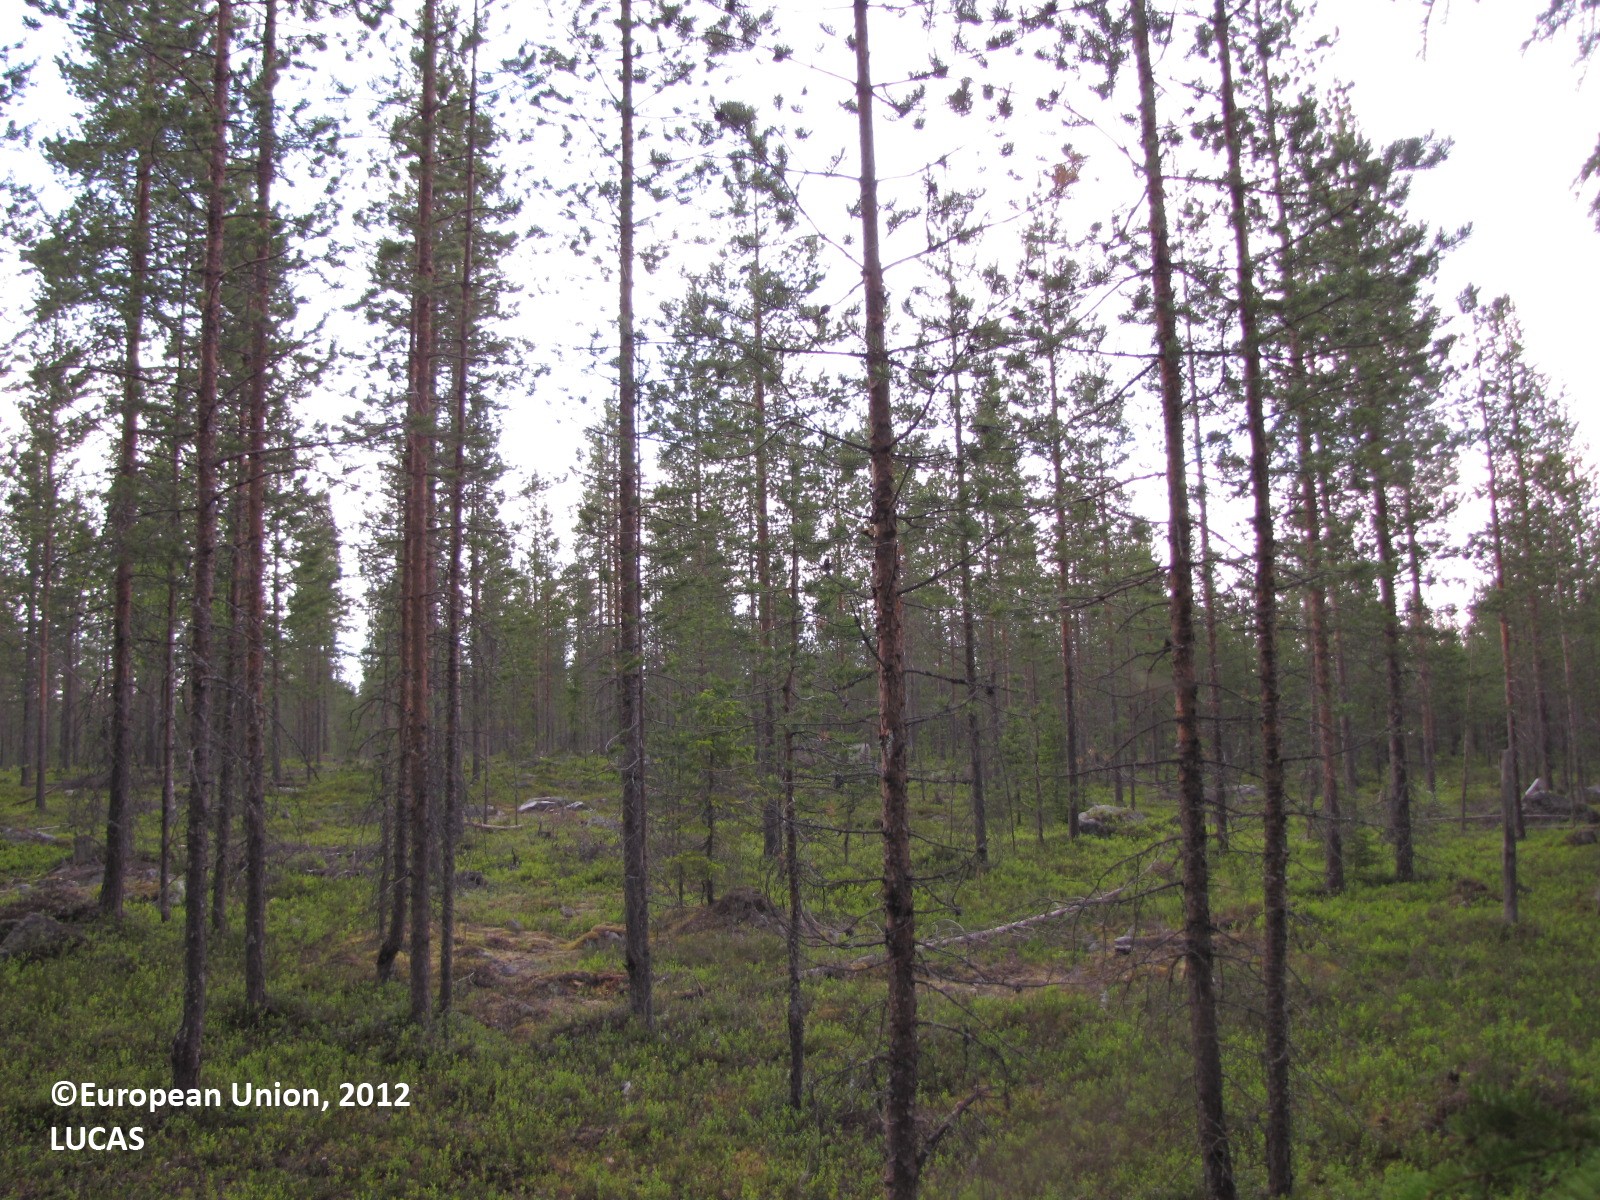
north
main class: Woodland
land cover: Pine dominated coniferous woodland
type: boreal forest
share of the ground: 50 - 75 %
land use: Forestry
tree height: > 5 m
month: July
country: FI
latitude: 66.3958
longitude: 25.2110
